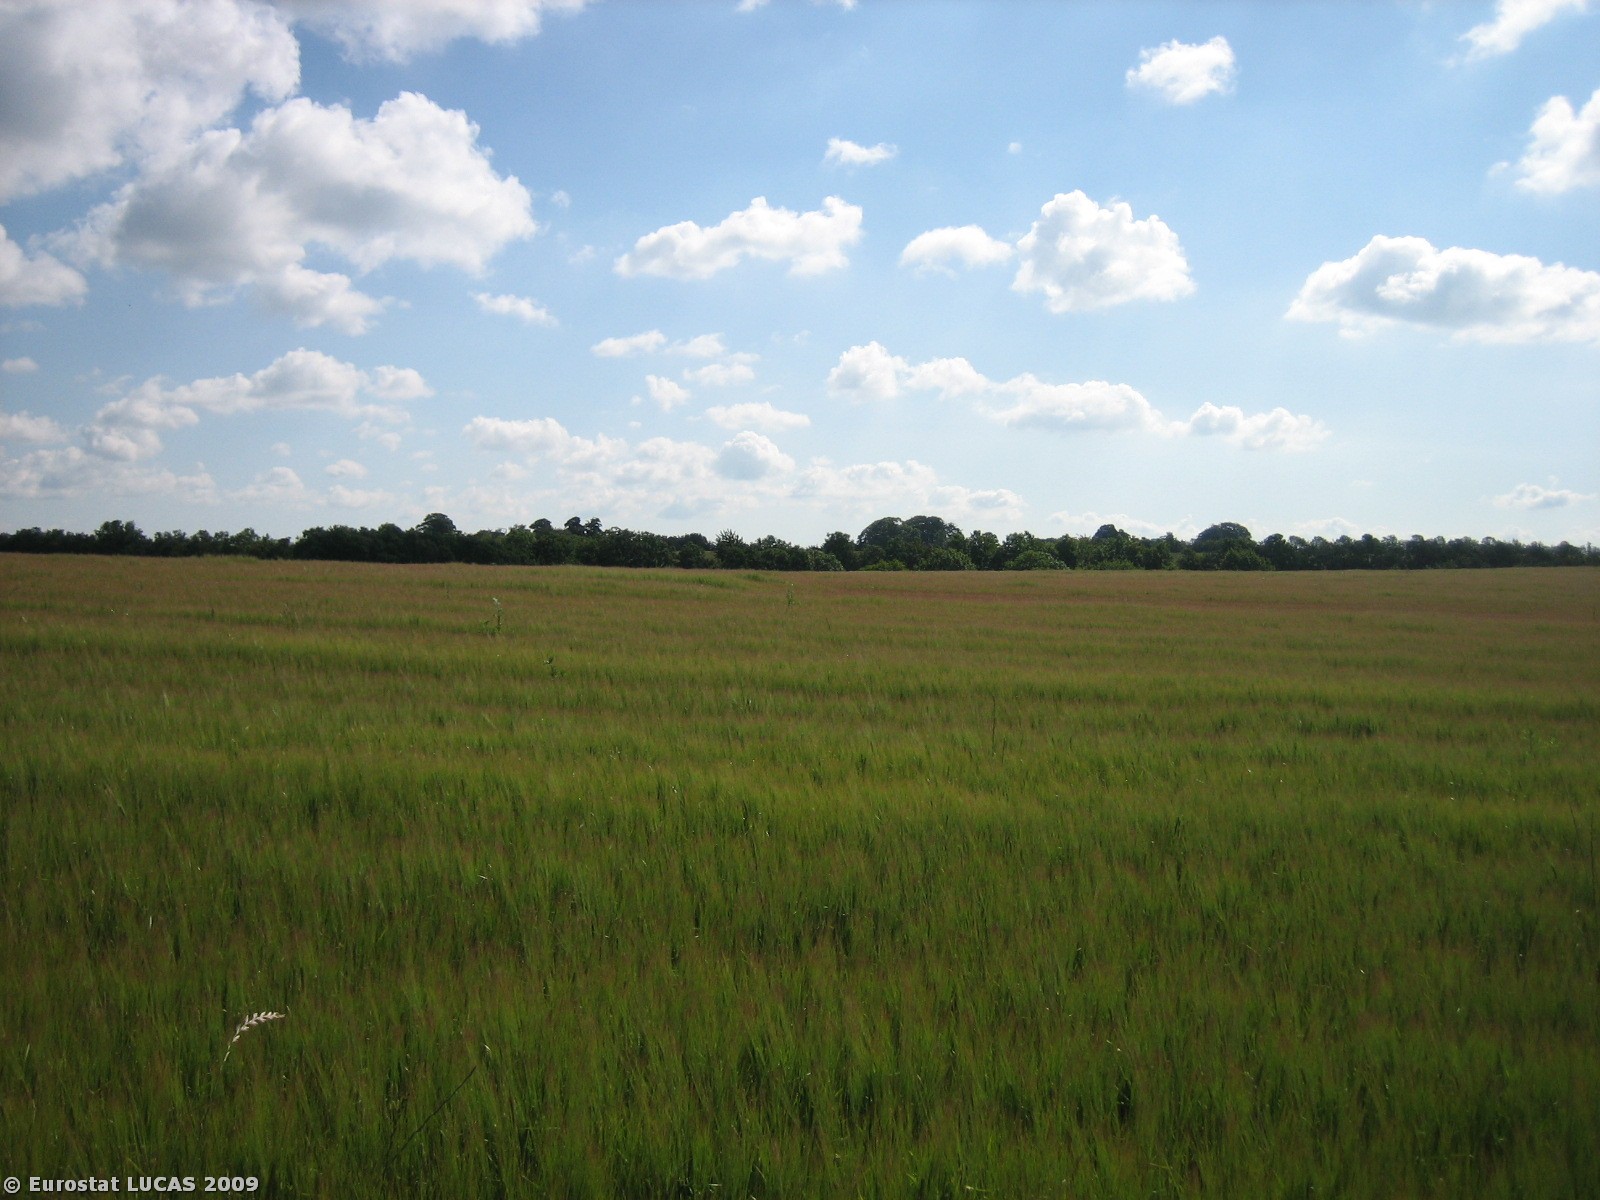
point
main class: Cropland
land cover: Barley
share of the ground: > 75 %
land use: Agriculture (excluding fallow land and kitchen gardens)
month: June
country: DK
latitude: 55.5207
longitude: 9.2879
